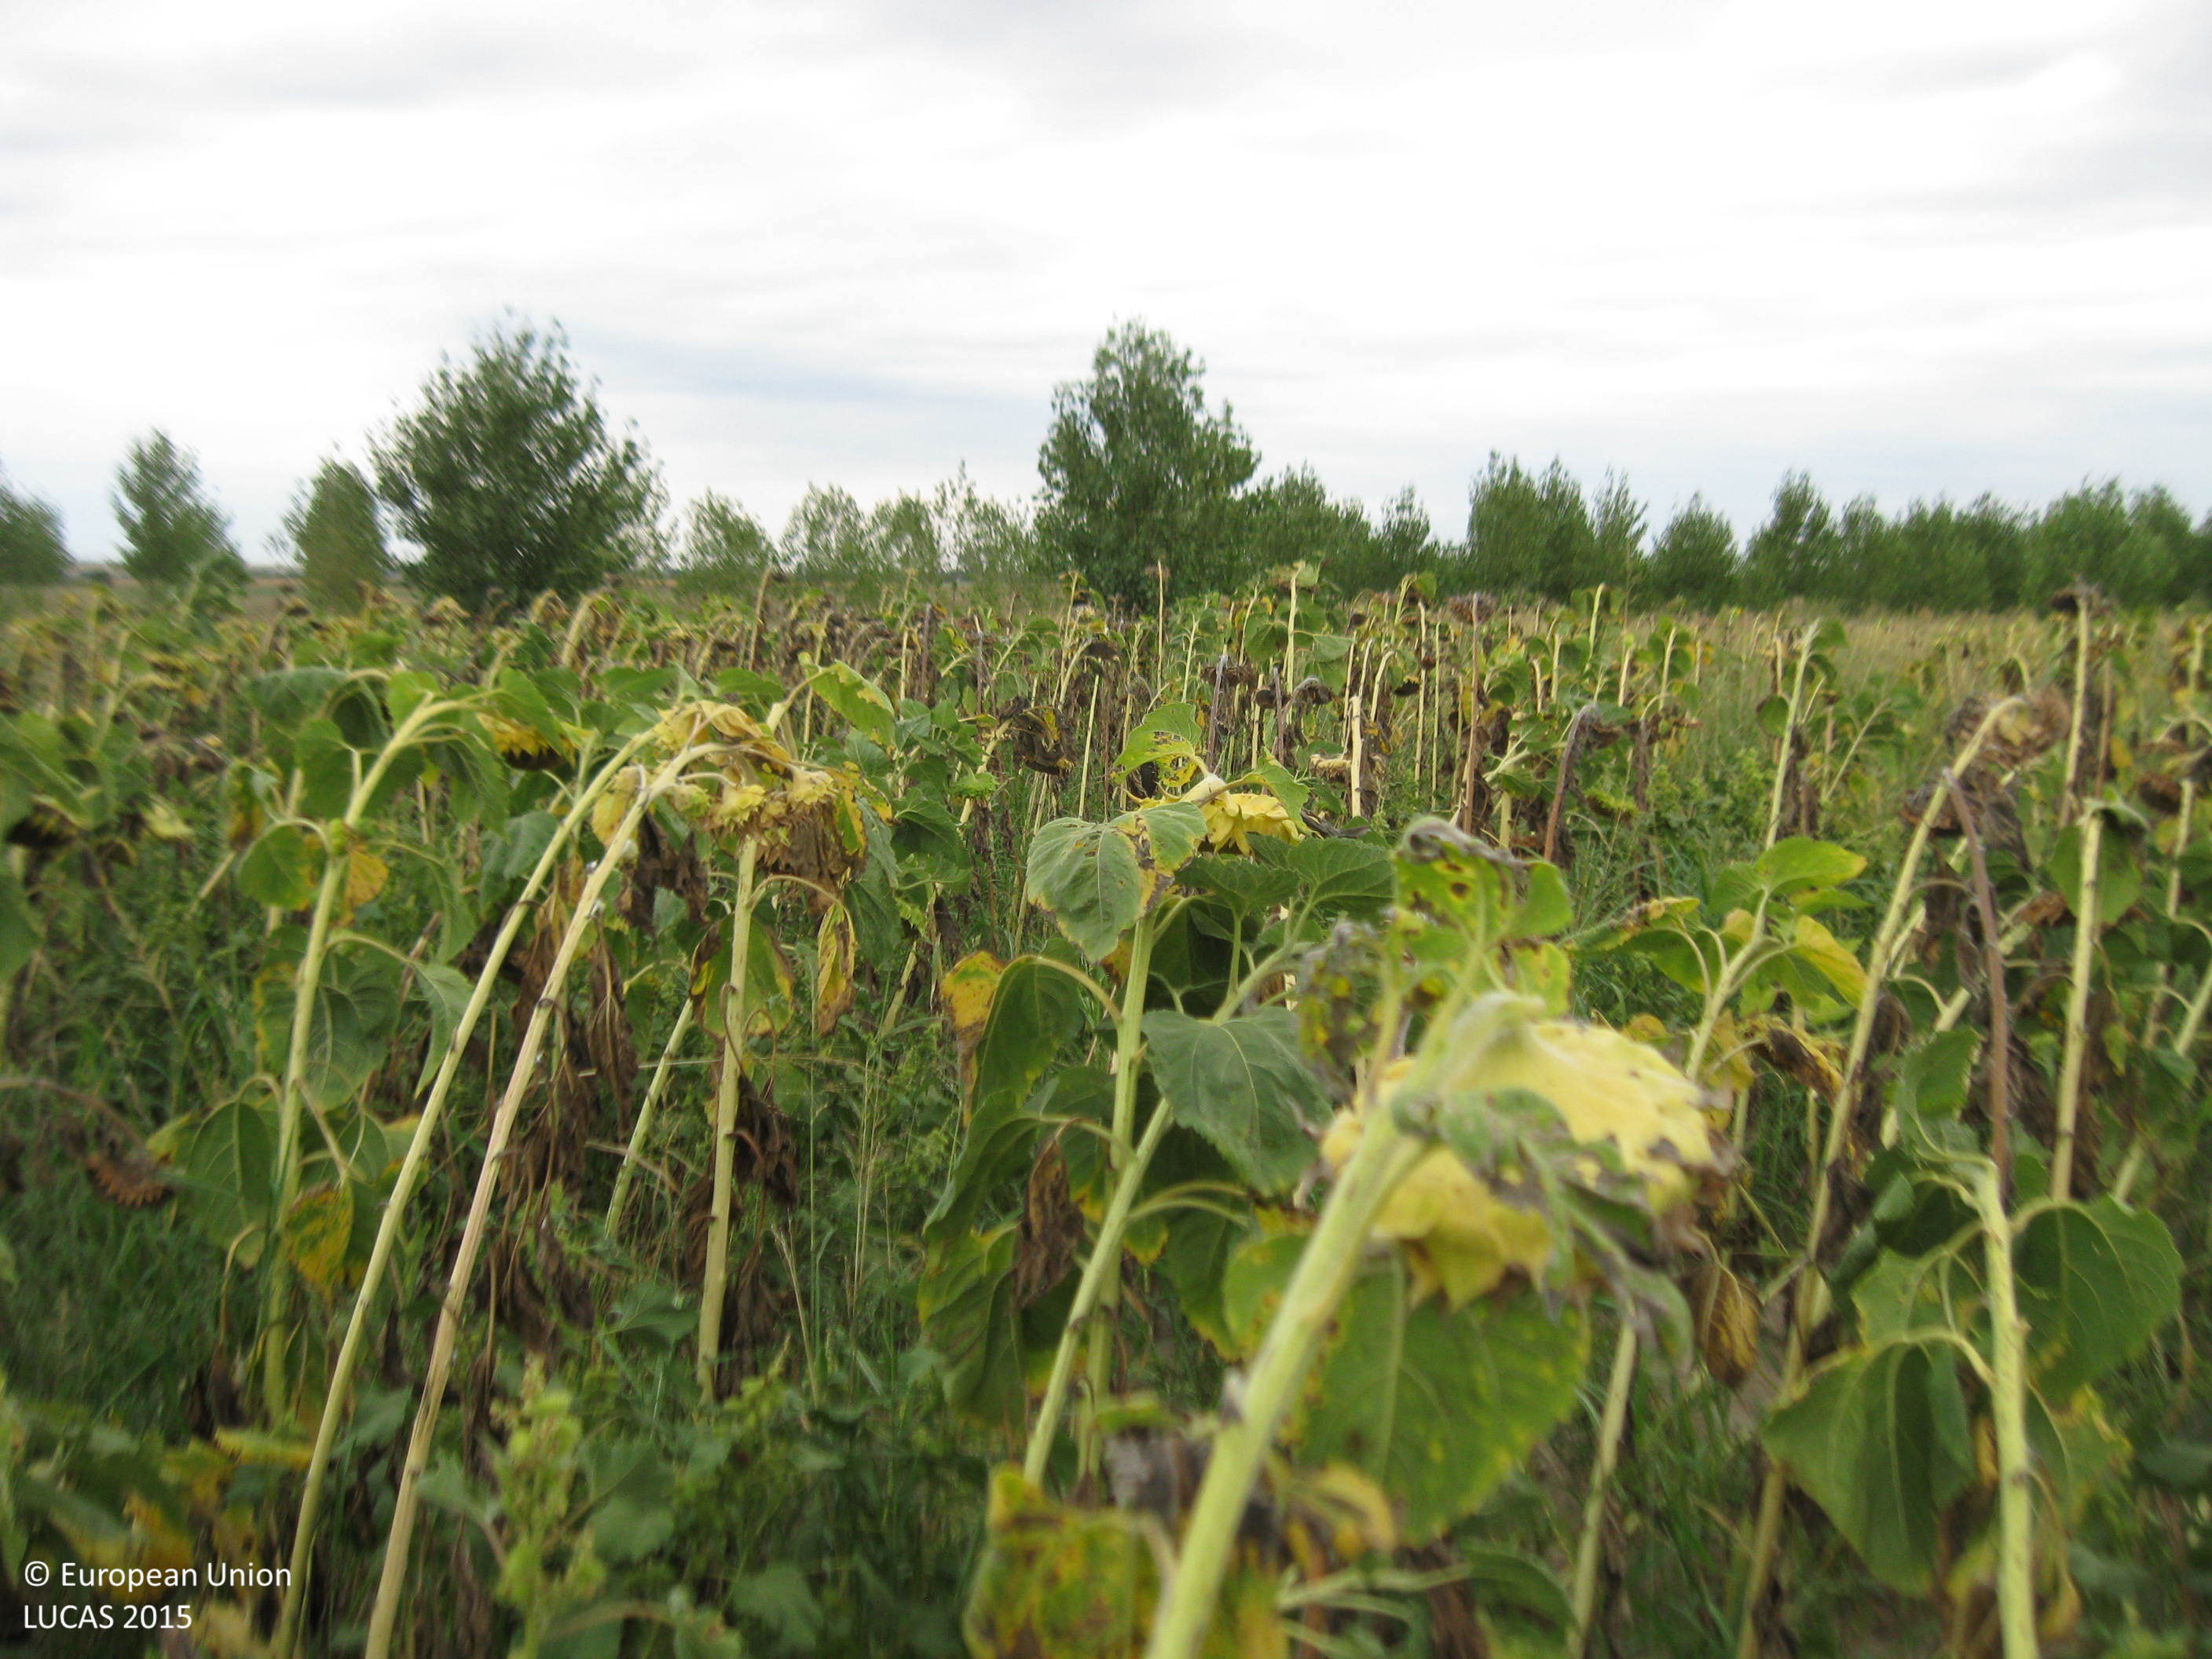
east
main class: Cropland
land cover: Sunflower
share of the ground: 50 - 75 %
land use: Agriculture (excluding fallow land and kitchen gardens)
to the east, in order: Sunflower; Grass margins; Lines of trees; Tracks; Spontaneously vegetated surfaces; Broadleaved woodland; Spontaneously vegetated surfaces; Lucerne
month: September
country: BG
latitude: 42.0610
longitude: 25.0034
